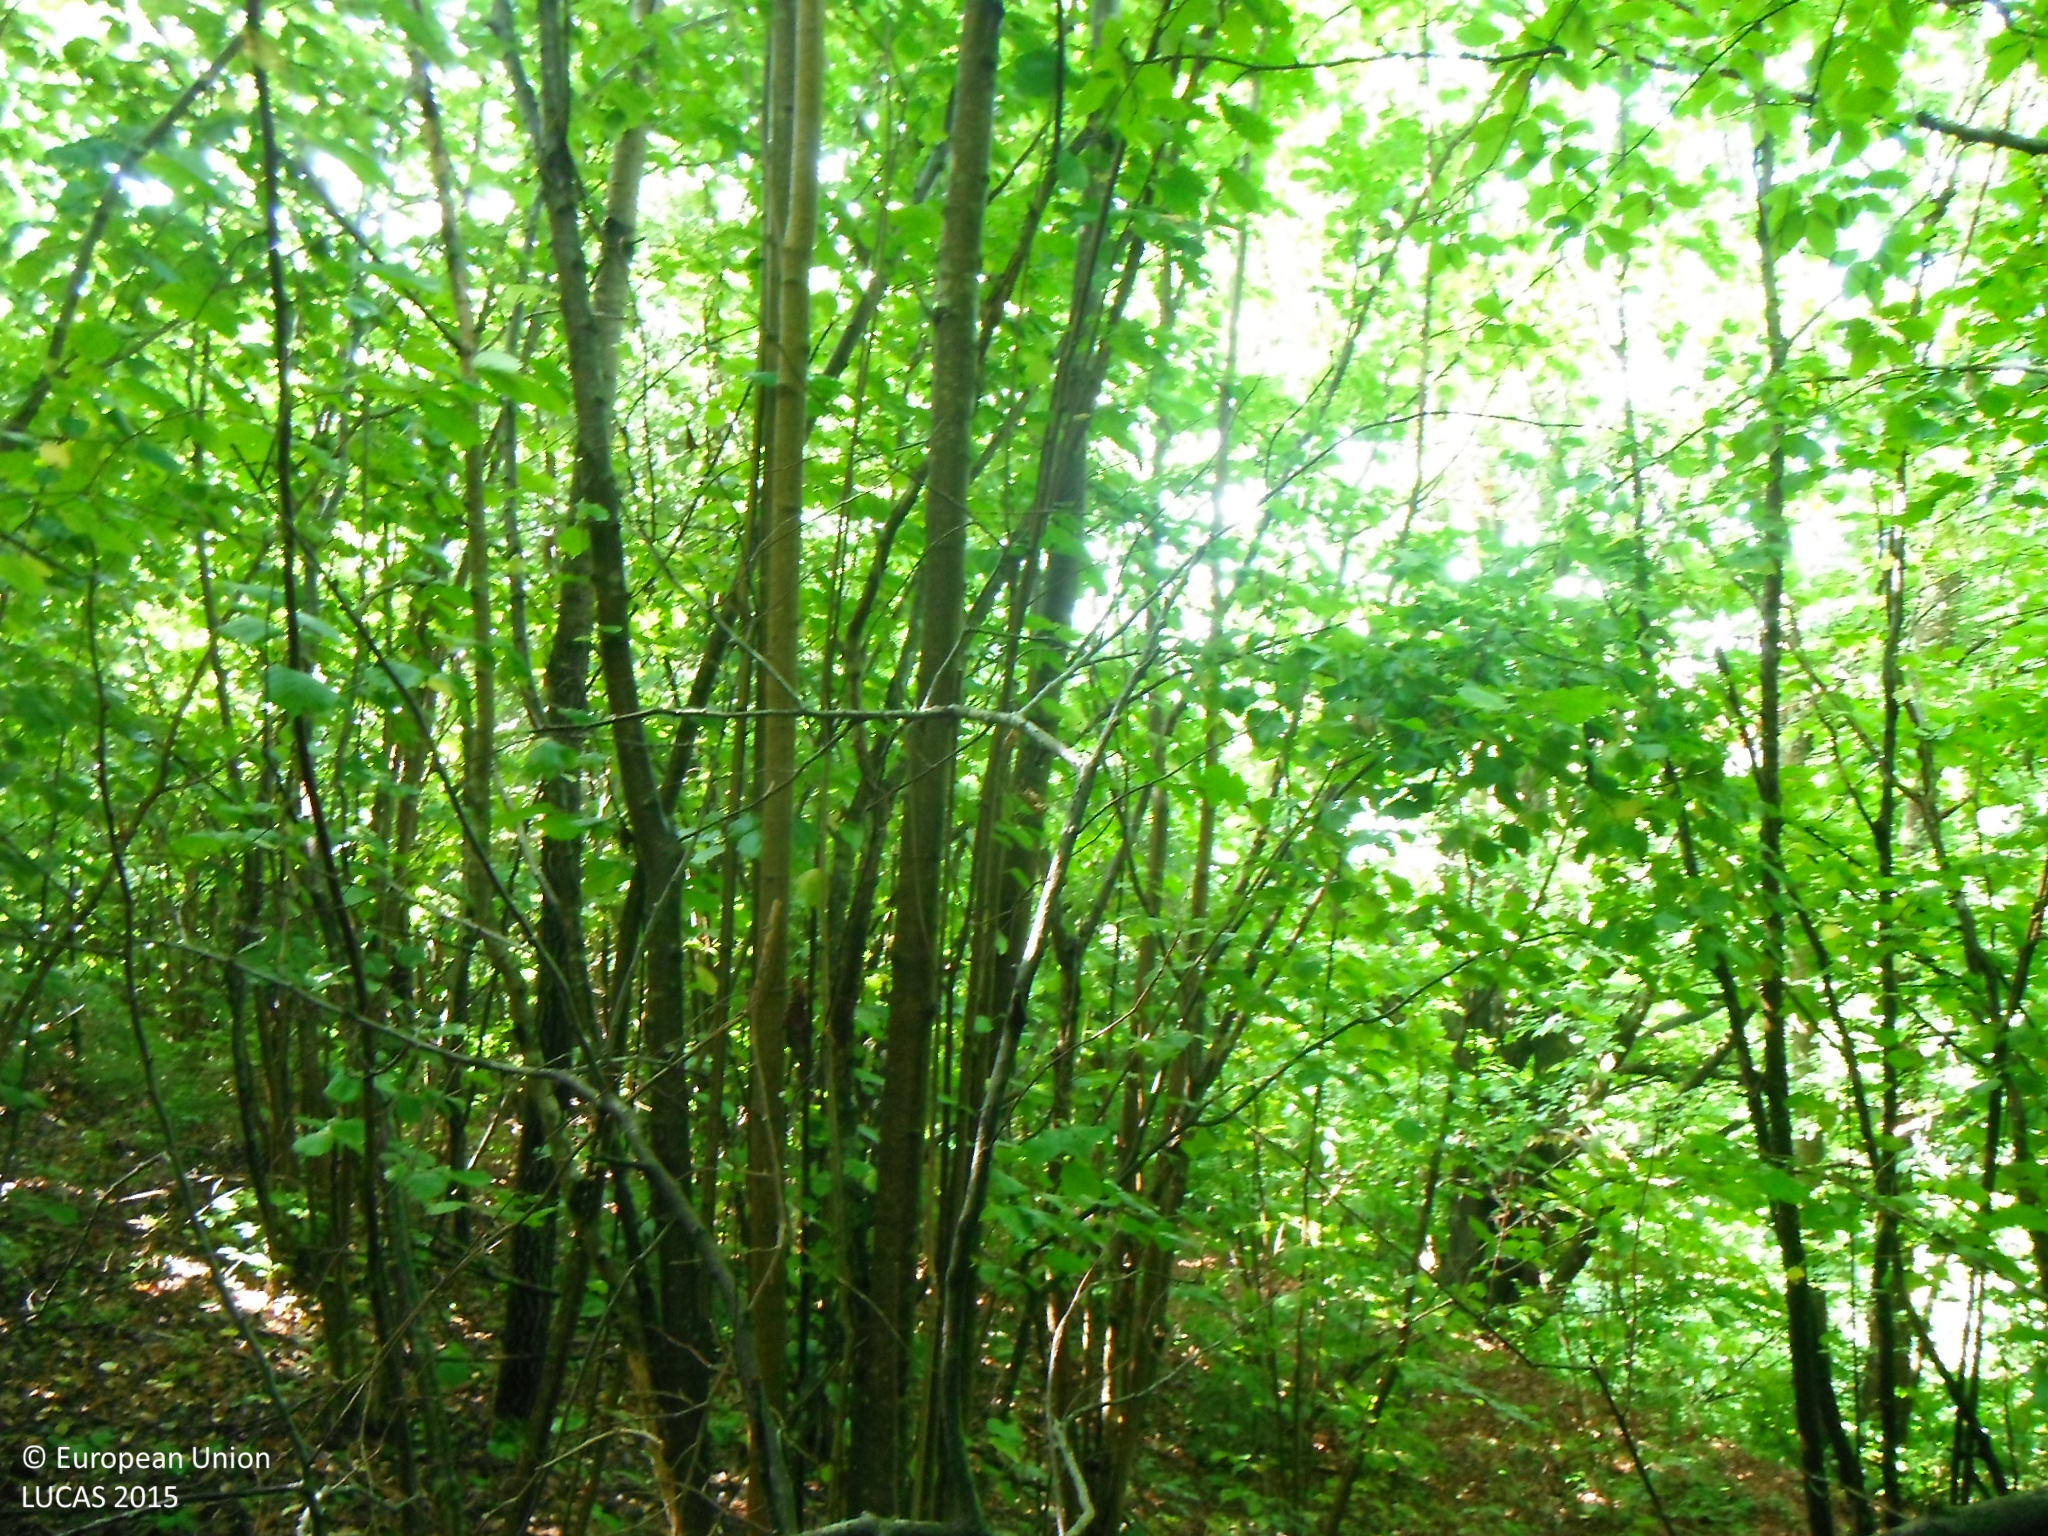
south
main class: Woodland
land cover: Broadleaved woodland
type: mesophytic deciduous forest
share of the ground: > 75 %
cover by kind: broadleaved forest trees 100 %
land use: Semi-natural and natural areas not in use
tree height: > 5 m
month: July
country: SK
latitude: 48.8538
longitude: 19.6078
